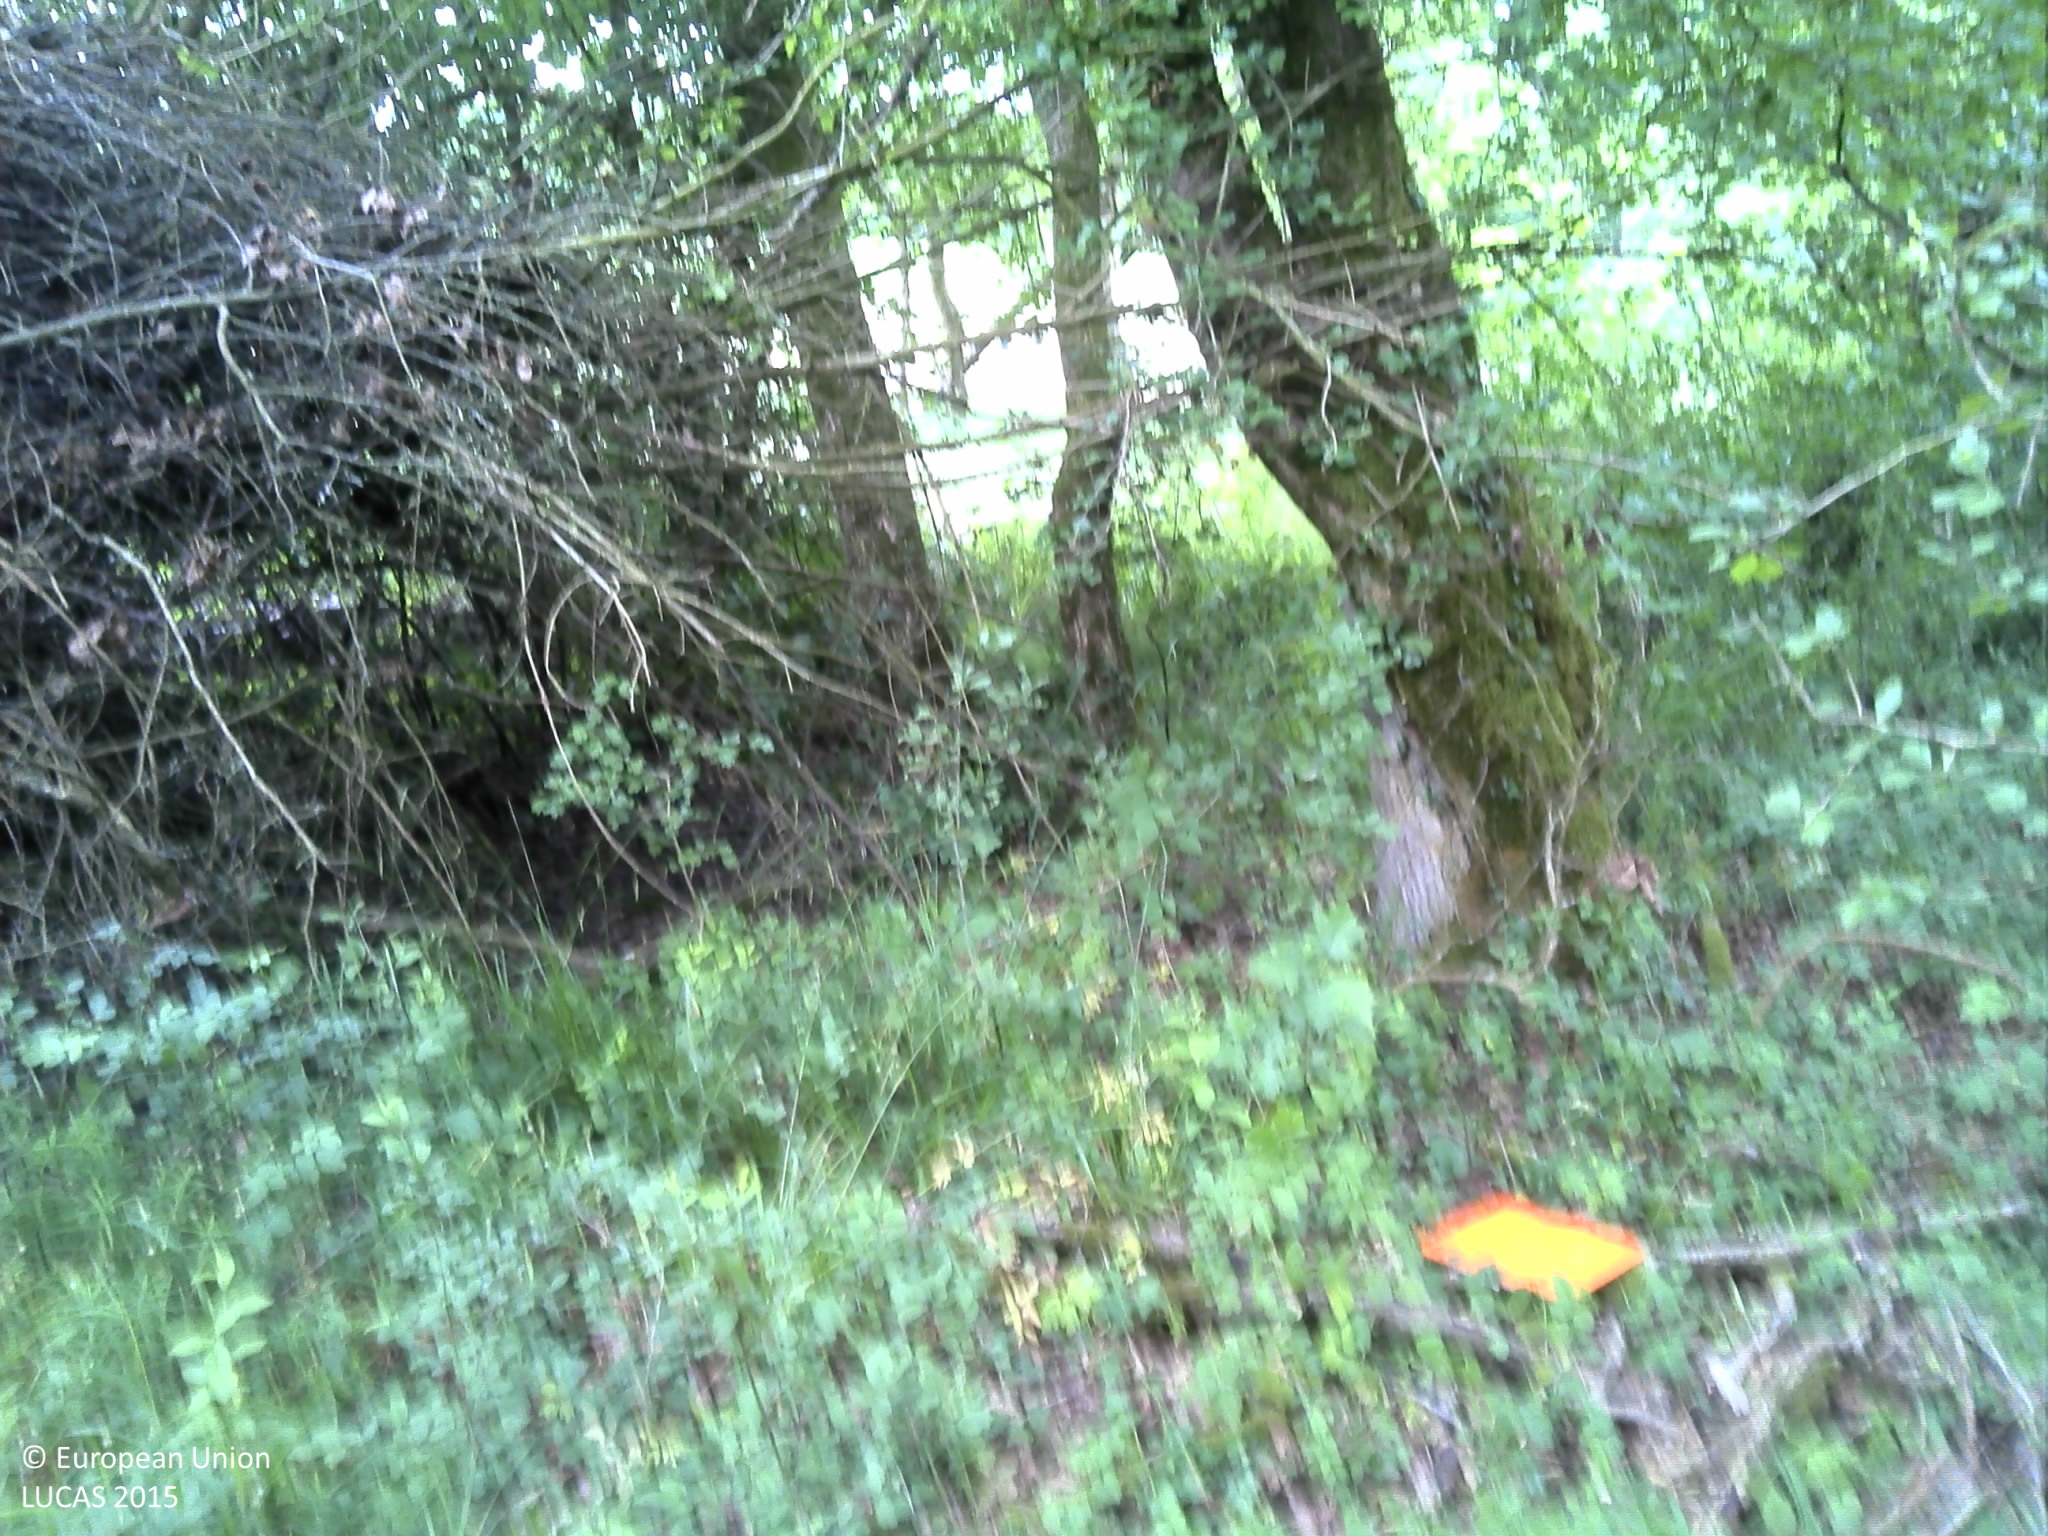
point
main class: Woodland
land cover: Broadleaved woodland
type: beech forest
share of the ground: > 75 %
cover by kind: broadleaved forest trees 85 %, herbaceous plants 10 %, shrubs 5 %
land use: Forestry
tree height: > 5 m
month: June
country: FR
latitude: 48.7722
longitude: 6.8301
